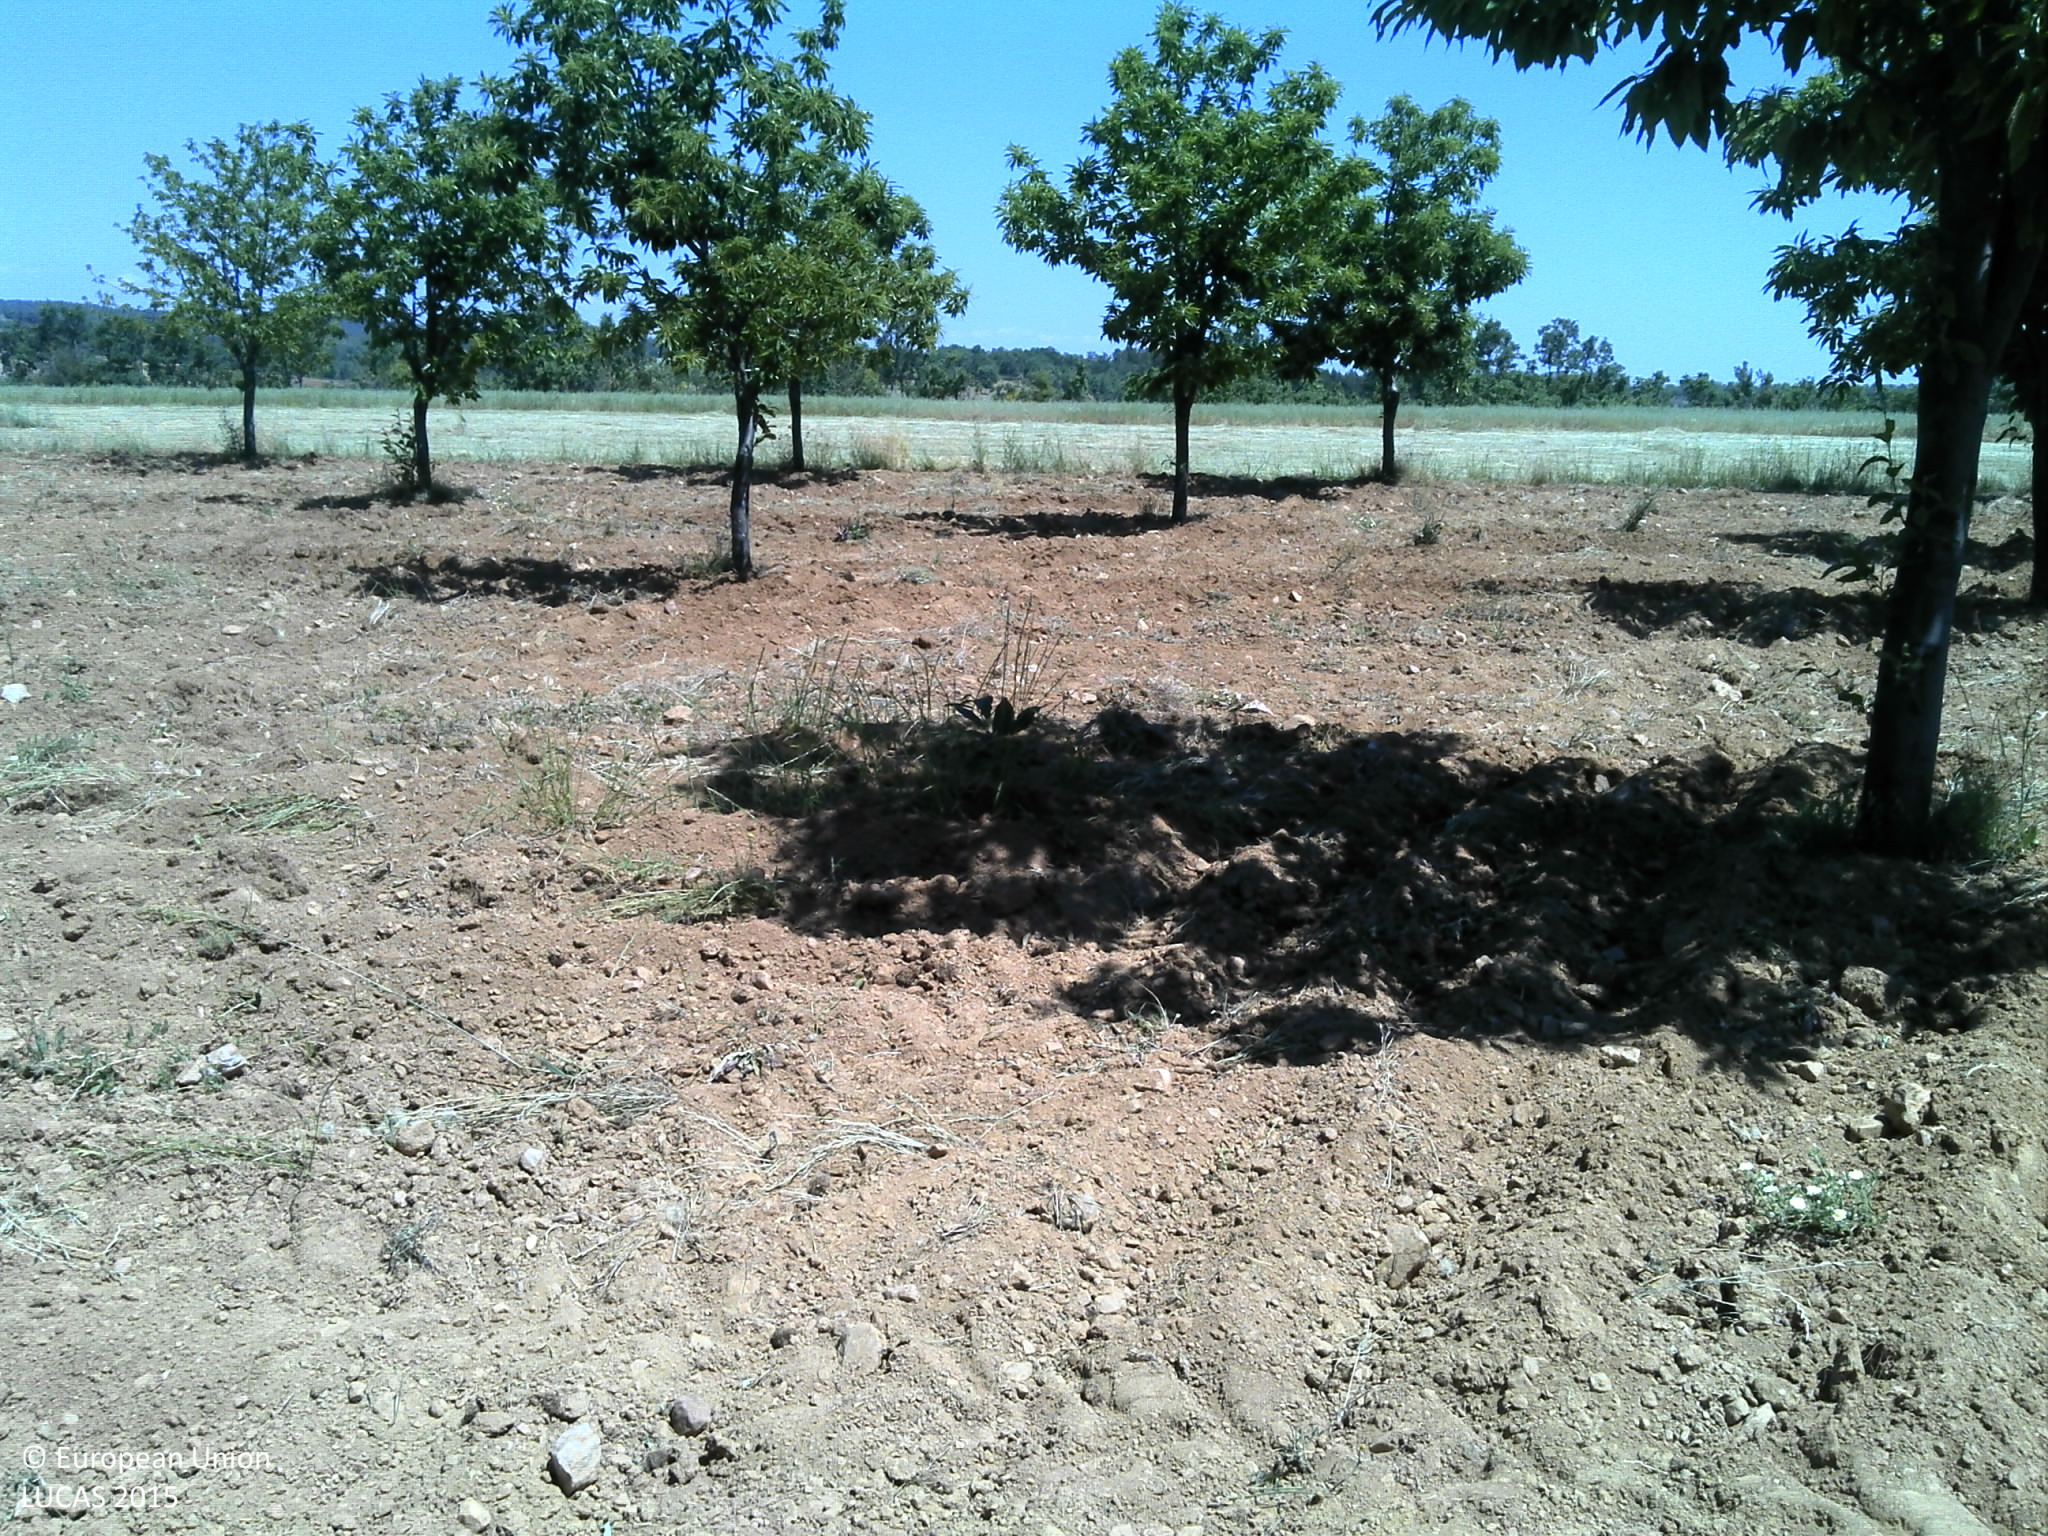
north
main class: Cropland
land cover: Nuts trees
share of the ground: 10 - 25 %
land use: Agriculture (excluding fallow land and kitchen gardens)
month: May
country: PT
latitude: 41.5293
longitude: -6.3880
